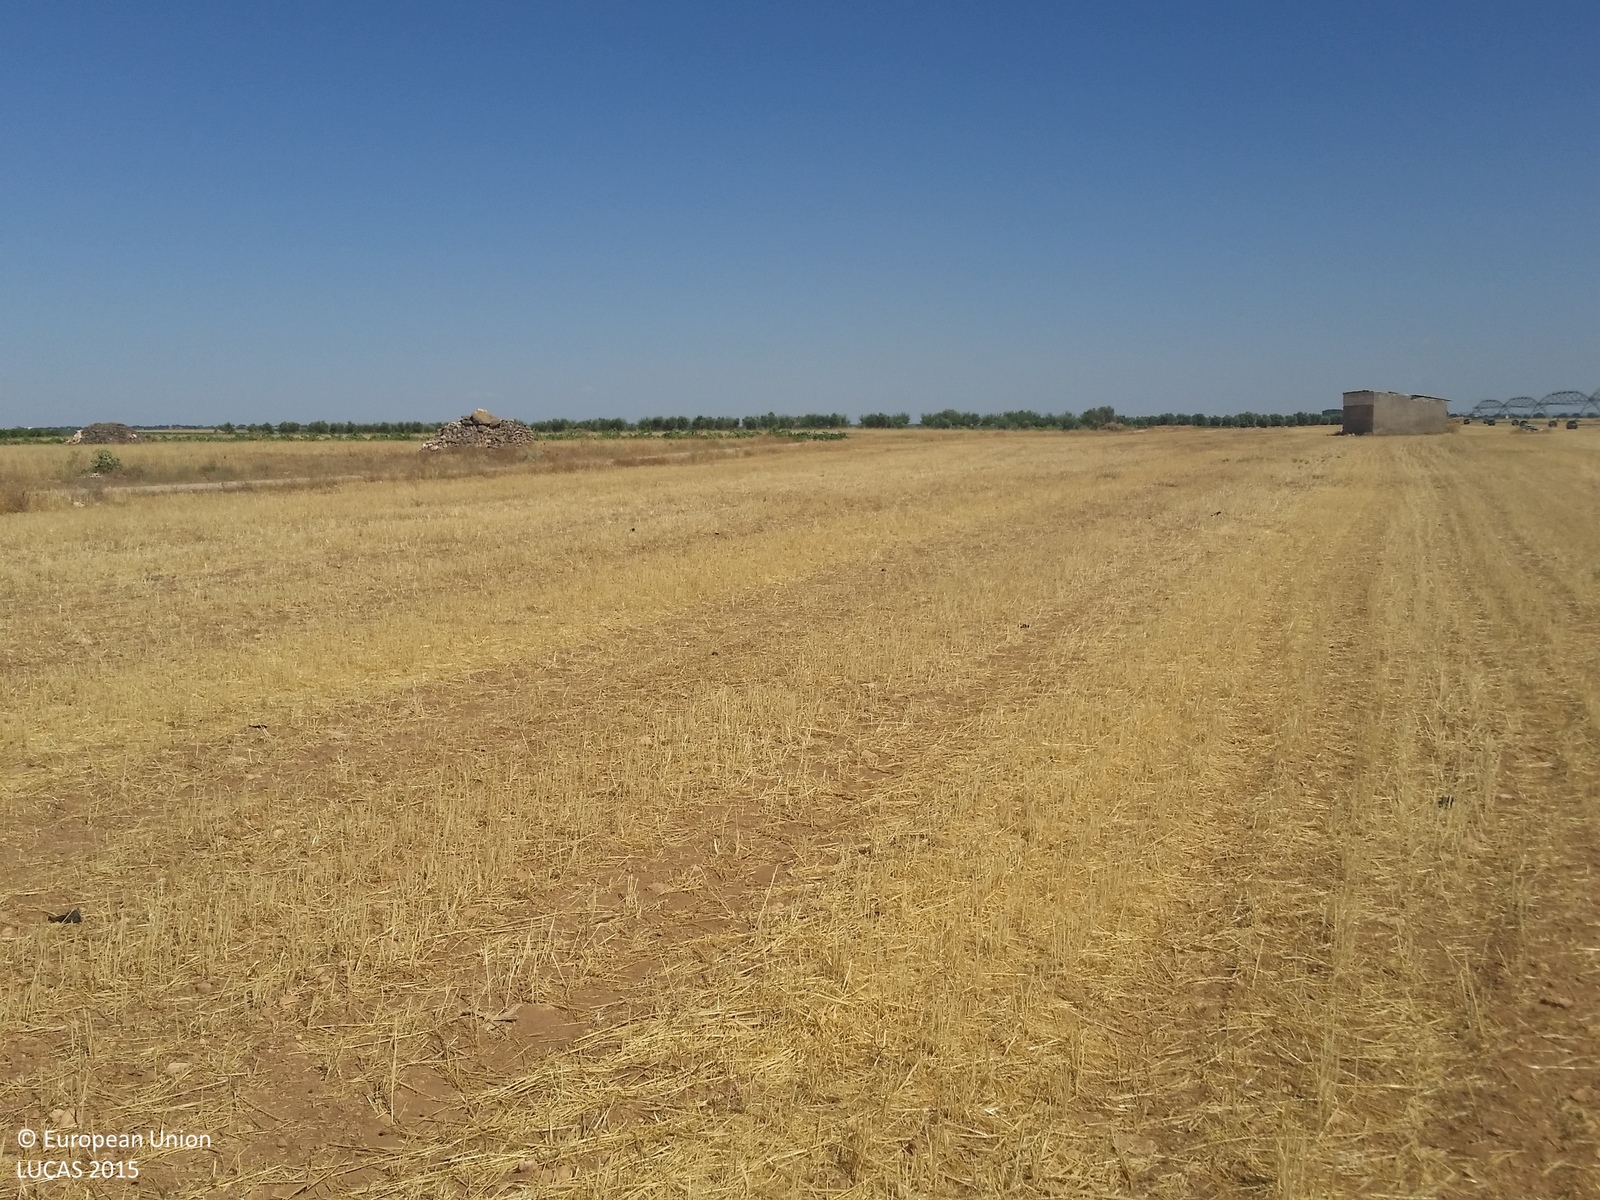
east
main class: Cropland
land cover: Barley
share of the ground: < 10 %
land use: Agriculture (excluding fallow land and kitchen gardens)
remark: Harvested field
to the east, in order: Barley; Grass margins; Tracks; Spontaneously vegetated surfaces; Barley; Vineyards; Spontaneously vegetated surfaces; Vineyards
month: July
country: ES
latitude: 39.2672
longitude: -2.7493
